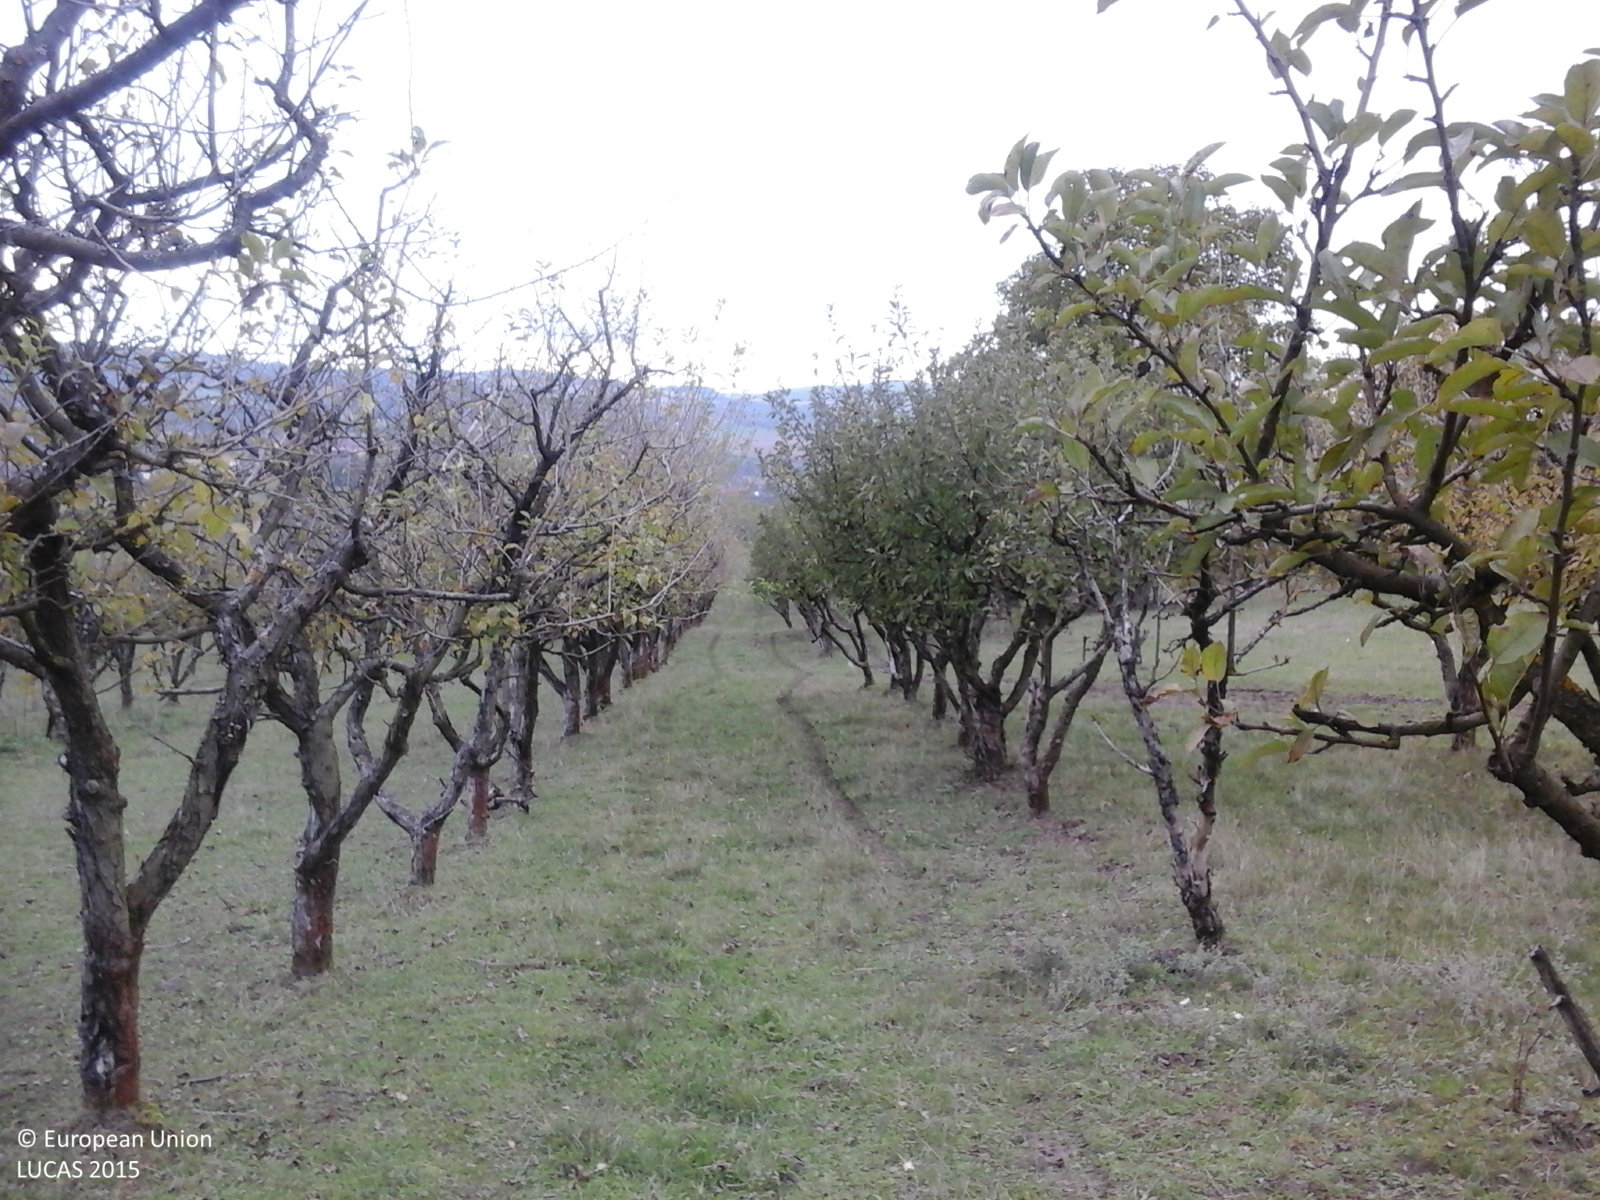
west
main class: Cropland
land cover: Apple fruit
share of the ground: > 75 %
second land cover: Grassland without tree/shrub cover
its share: > 75 %
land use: Agriculture (excluding fallow land and kitchen gardens)
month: October
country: RO
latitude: 45.9149
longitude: 24.8256
